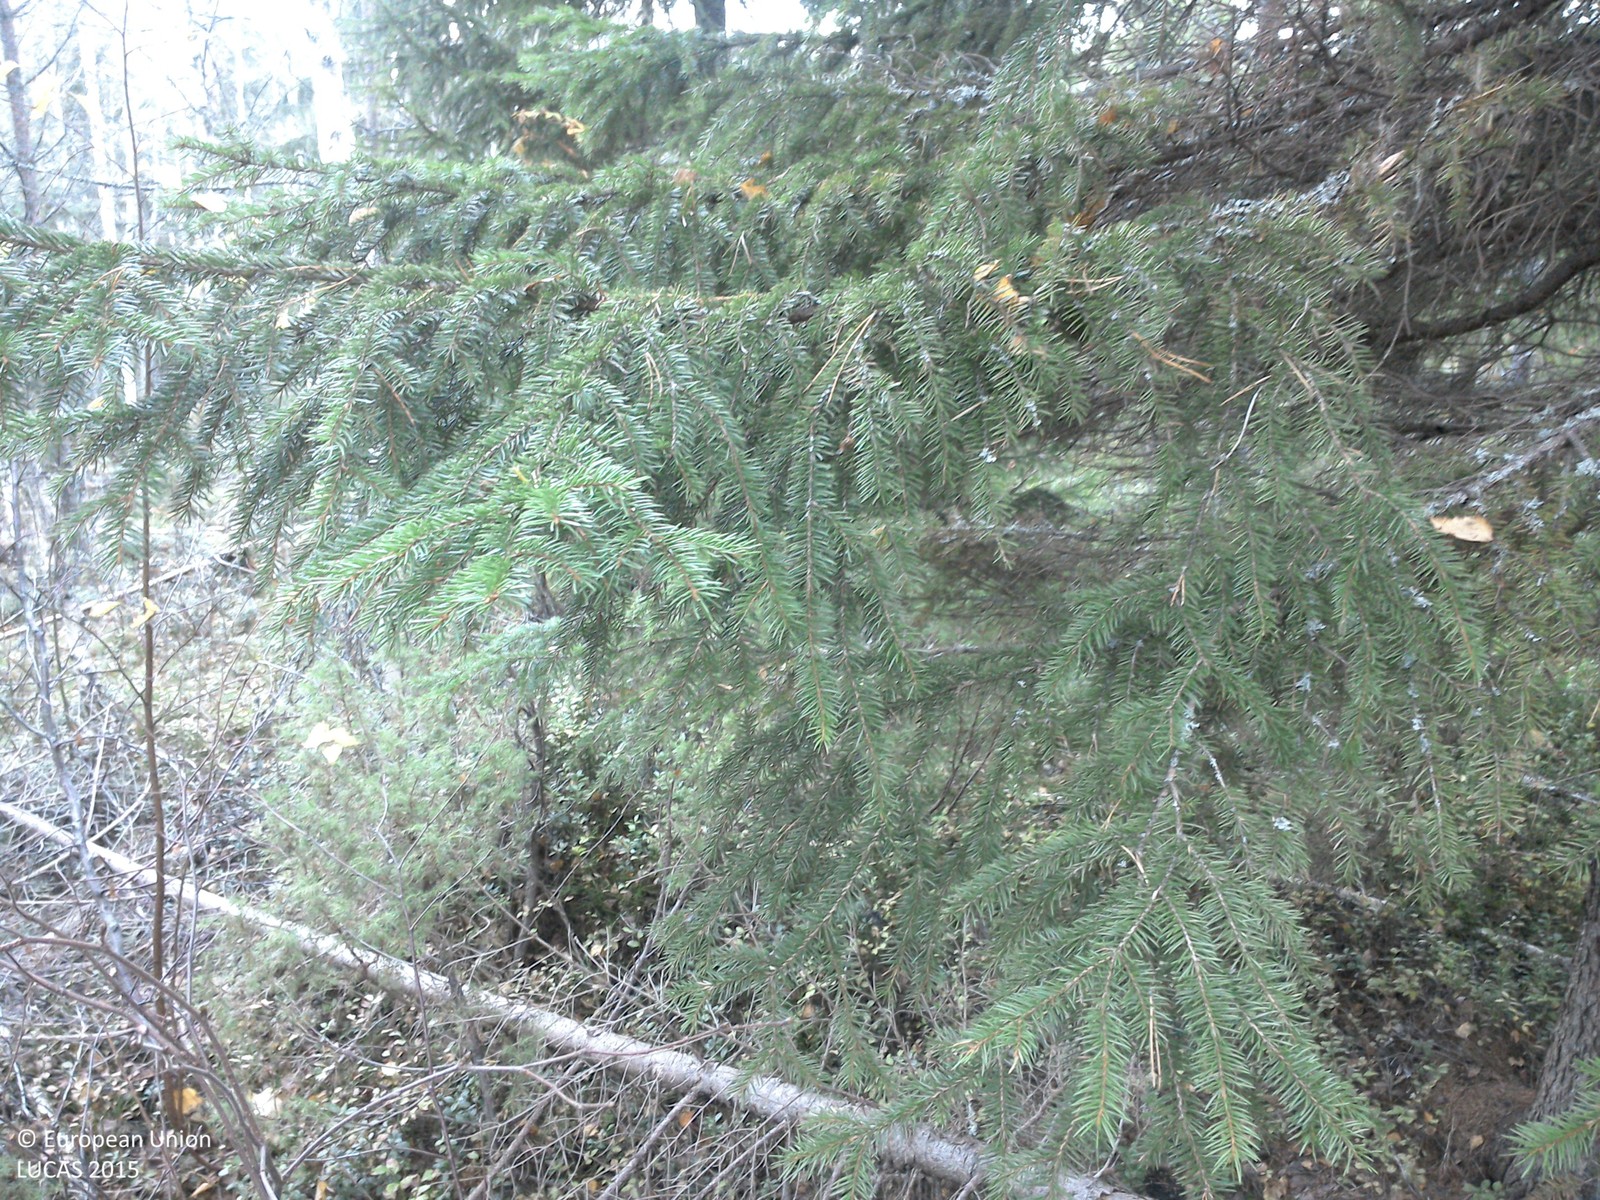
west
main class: Woodland
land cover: Other mixed woodland
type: boreal forest
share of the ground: 50 - 75 %
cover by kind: shrubs 45 %, coniferous forest trees 30 %, broadleaved forest trees 25 %
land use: Forestry
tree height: > 5 m
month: October
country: SE
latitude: 63.8931
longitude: 19.8163
